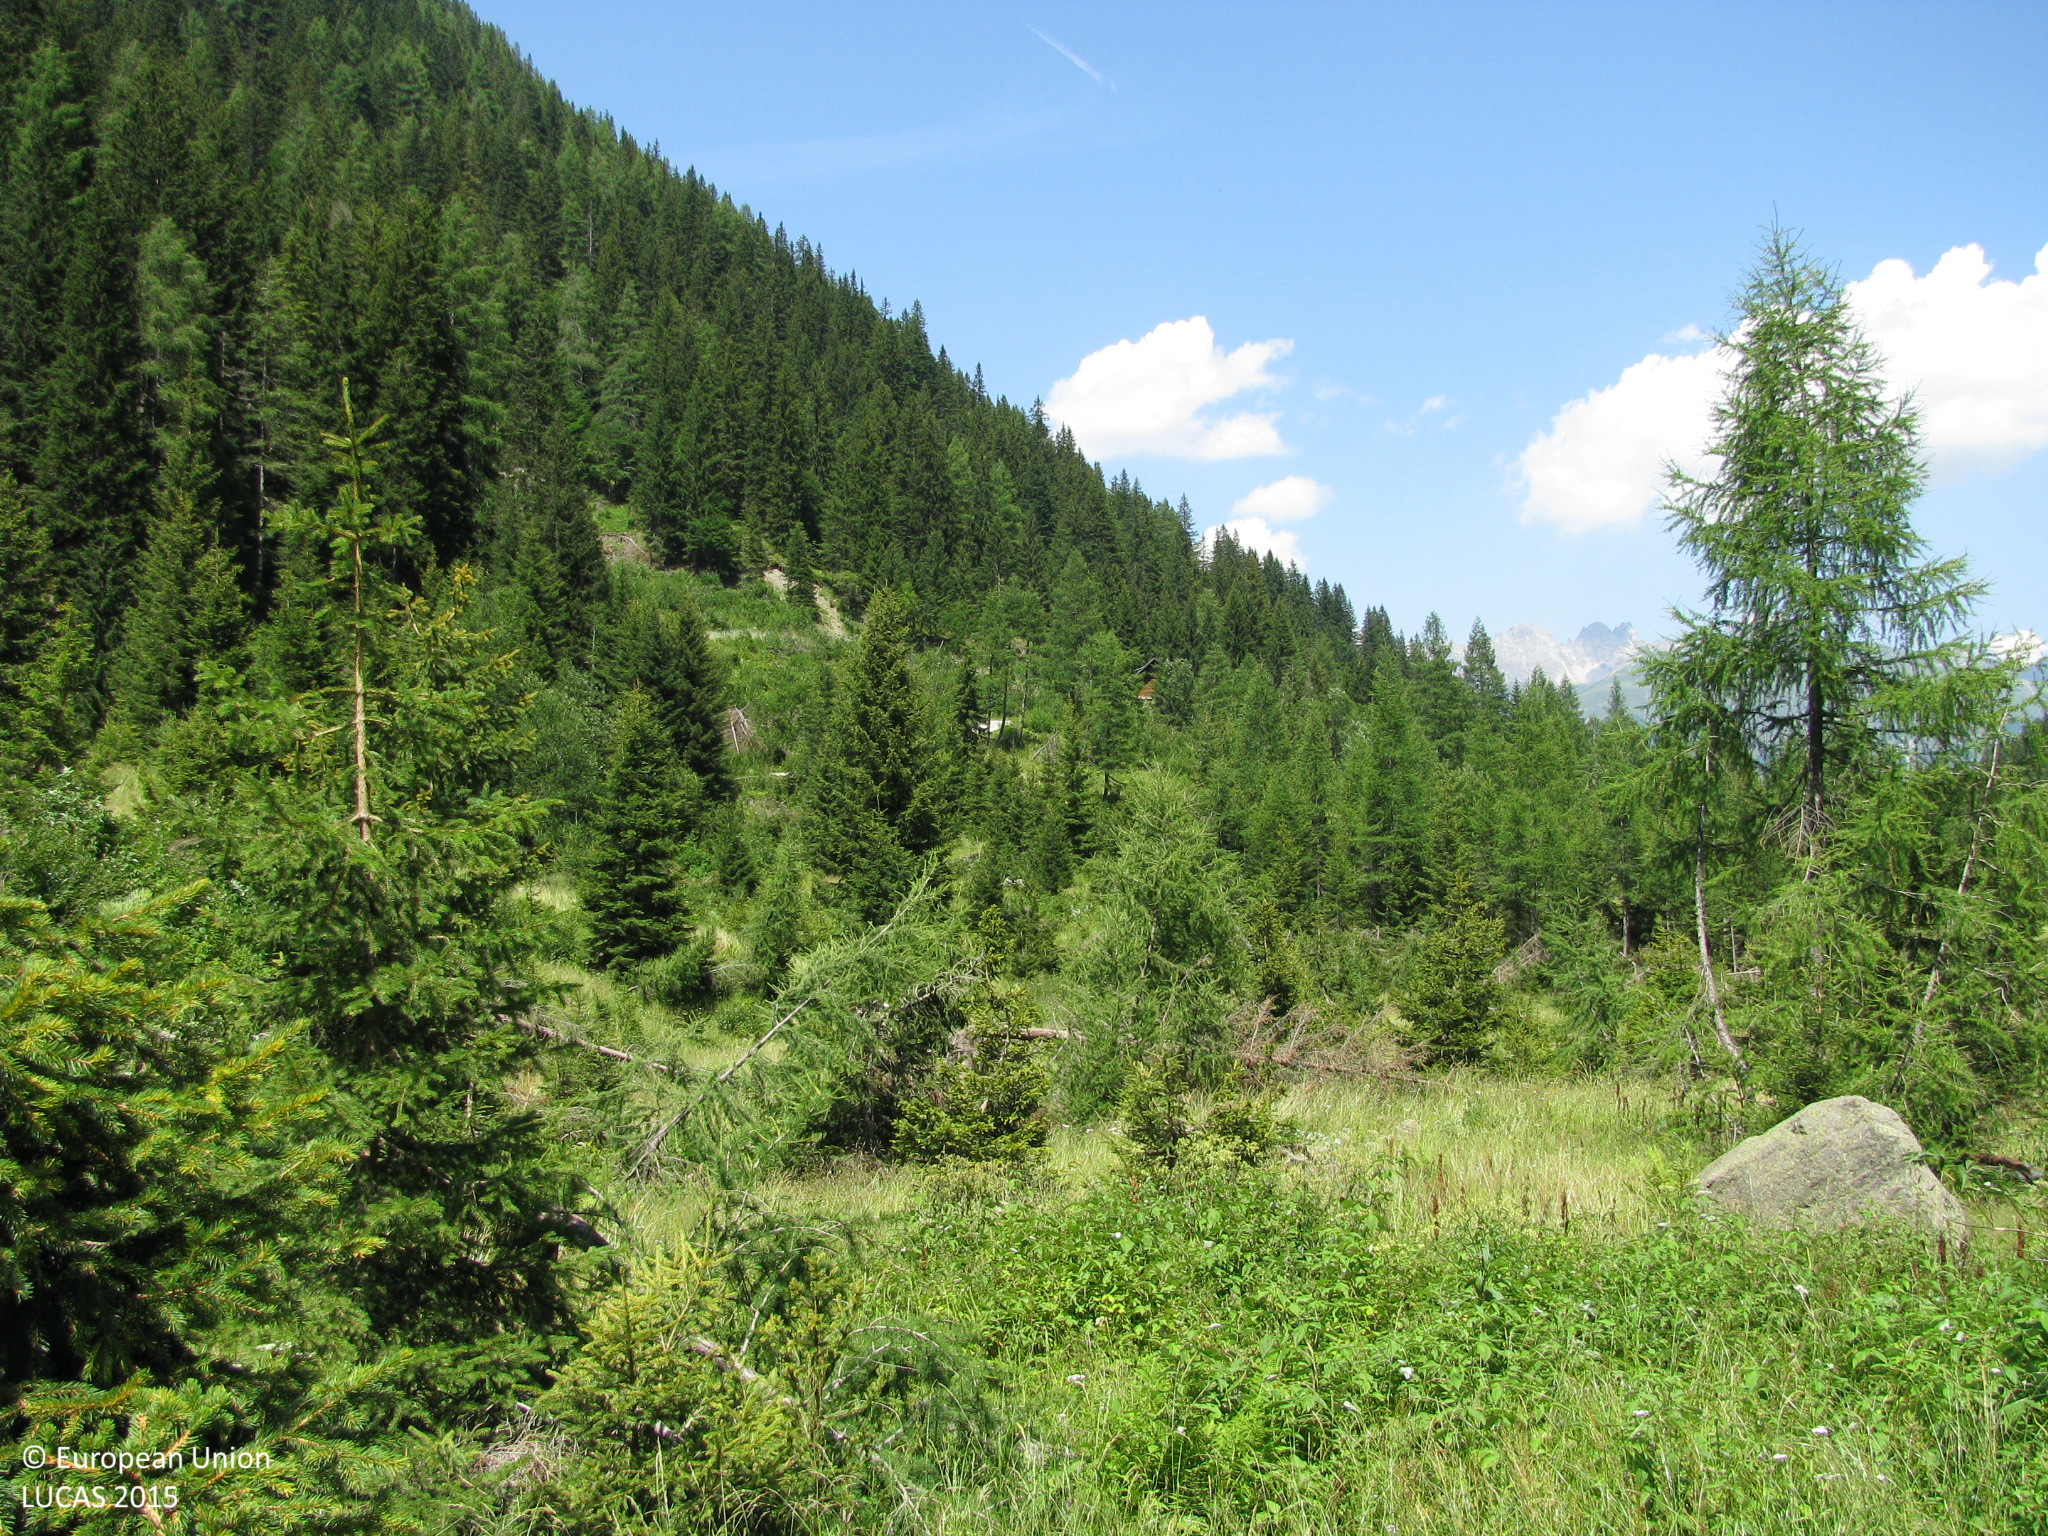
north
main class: Shrubland
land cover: Shrubland with sparse tree cover
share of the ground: > 75 %
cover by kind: herbaceous plants 70 %, shrubs 20 %, coniferous forest trees 5 %, consolidated bare surface 5 %
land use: Forestry
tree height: < 5 m
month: July
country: AT
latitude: 46.6581
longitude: 12.7547
